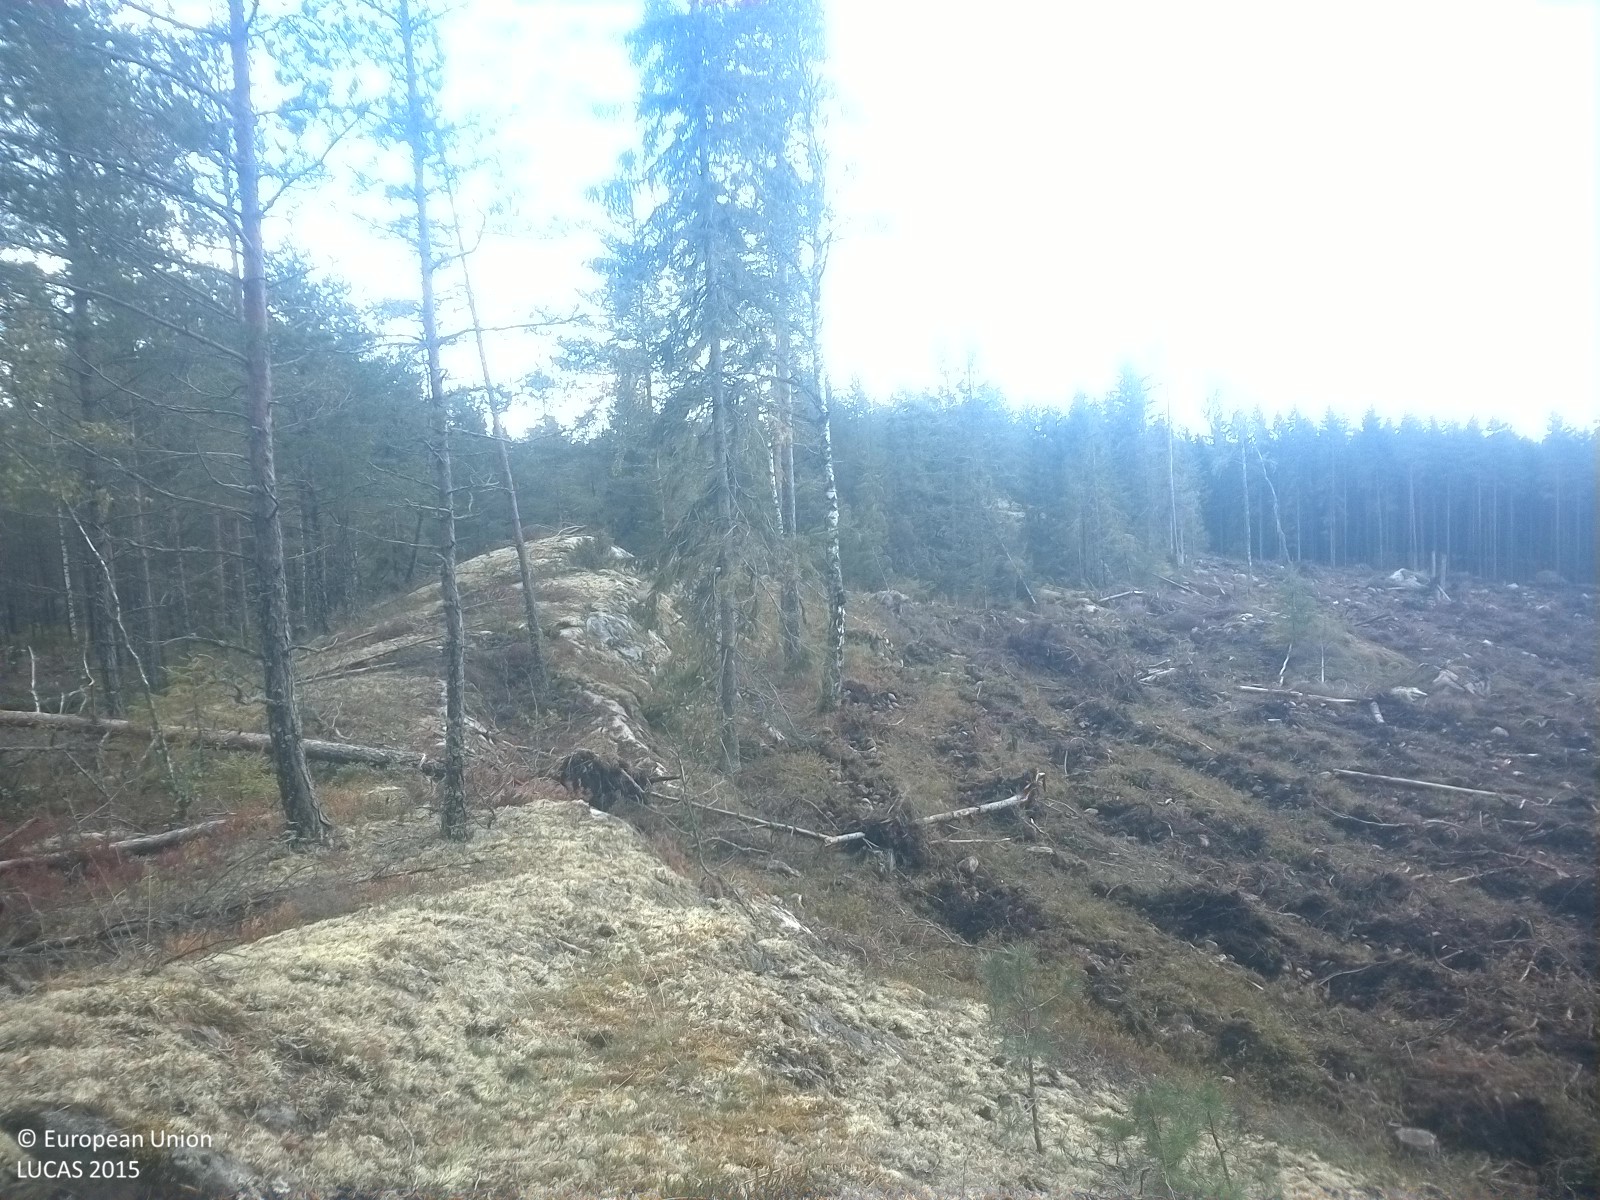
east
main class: Woodland
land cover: Pine dominated coniferous woodland
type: boreal forest
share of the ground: 10 - 25 %
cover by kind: lichens and mosses 60 %, coniferous forest trees 20 %, shrubs 15 %, herbaceous plants 5 %
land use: Forestry
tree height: < 5 m
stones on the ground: 10 - 25 %
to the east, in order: Pine dominated coniferous woodland; Lichens and moss; Other bare soil; Pine dominated coniferous woodland; Tracks; Pine dominated coniferous woodland; Other bare soil
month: September
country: SE
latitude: 58.7981
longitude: 16.2073
